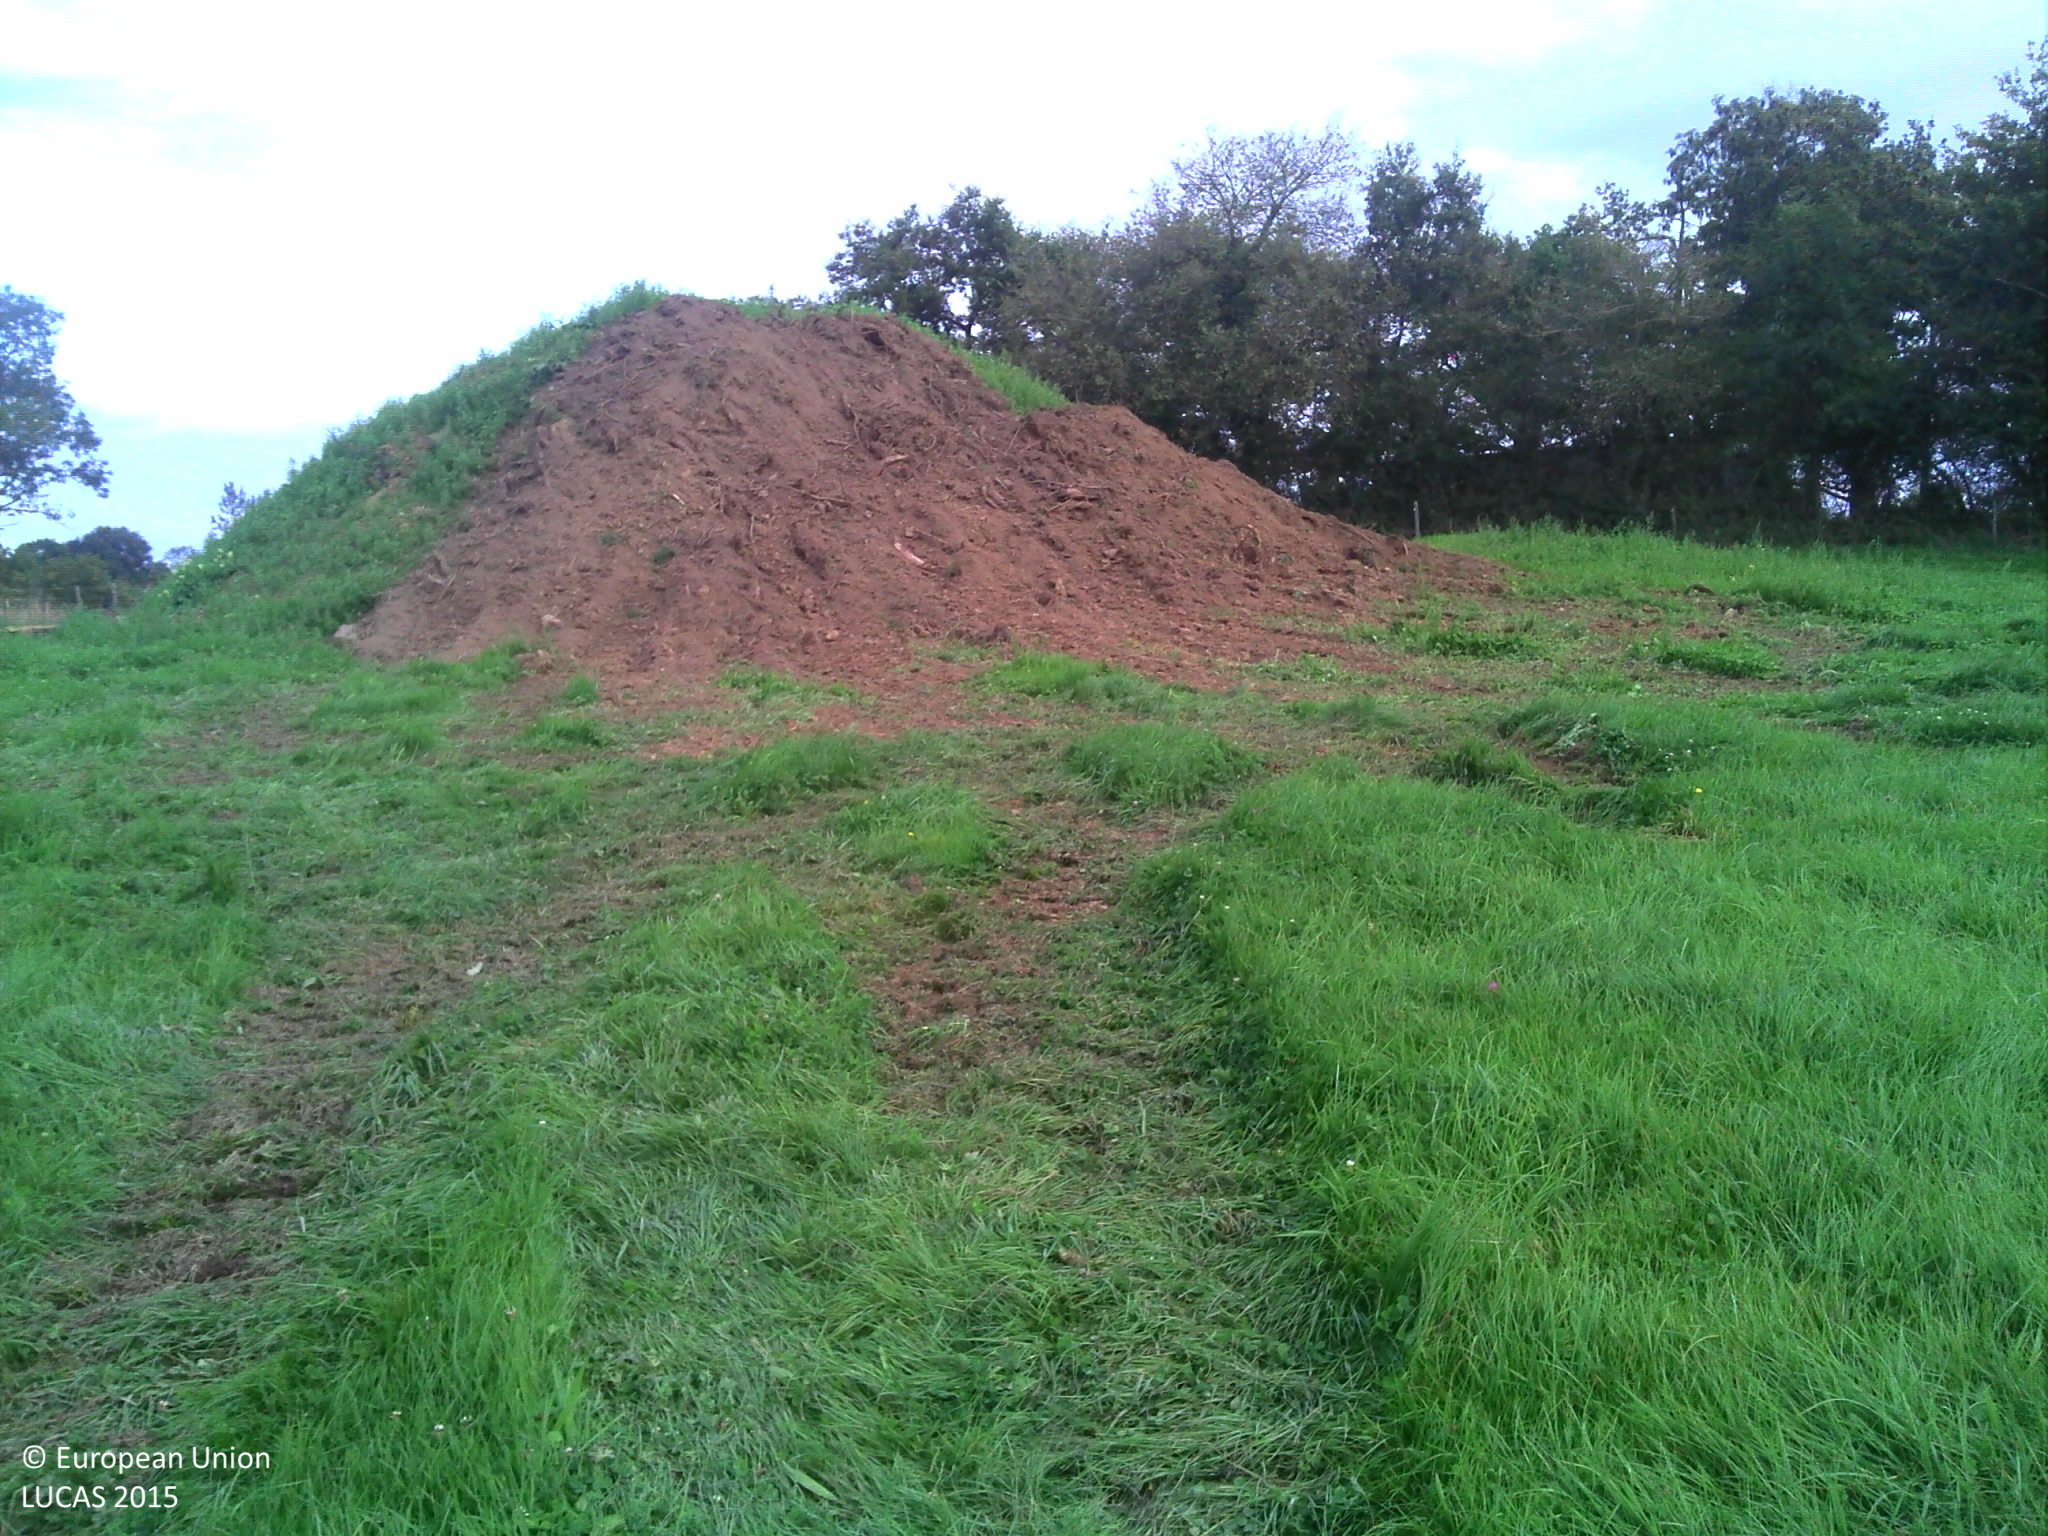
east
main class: Grassland
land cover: Grassland without tree/shrub cover
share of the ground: > 75 %
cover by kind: herbaceous plants 100 %
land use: Agriculture (excluding fallow land and kitchen gardens)
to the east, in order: Grassland without tree/shrub cover; Fences; Abandoned hedges; Fences; Broadleaved woodland; Fences; Grass margins; Other bare soil; Paved roads, cycling and walking lanes; Other bare soil; Grass margins; Ditches and canals; Grass margins; Fences; Grassland without tree/shrub cover; Managed hedges; Fences; Grassland without tree/shrub cover; Electric lines; Grassland without tree/shrub cover
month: September
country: FR
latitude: 46.7390
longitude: -0.8814
